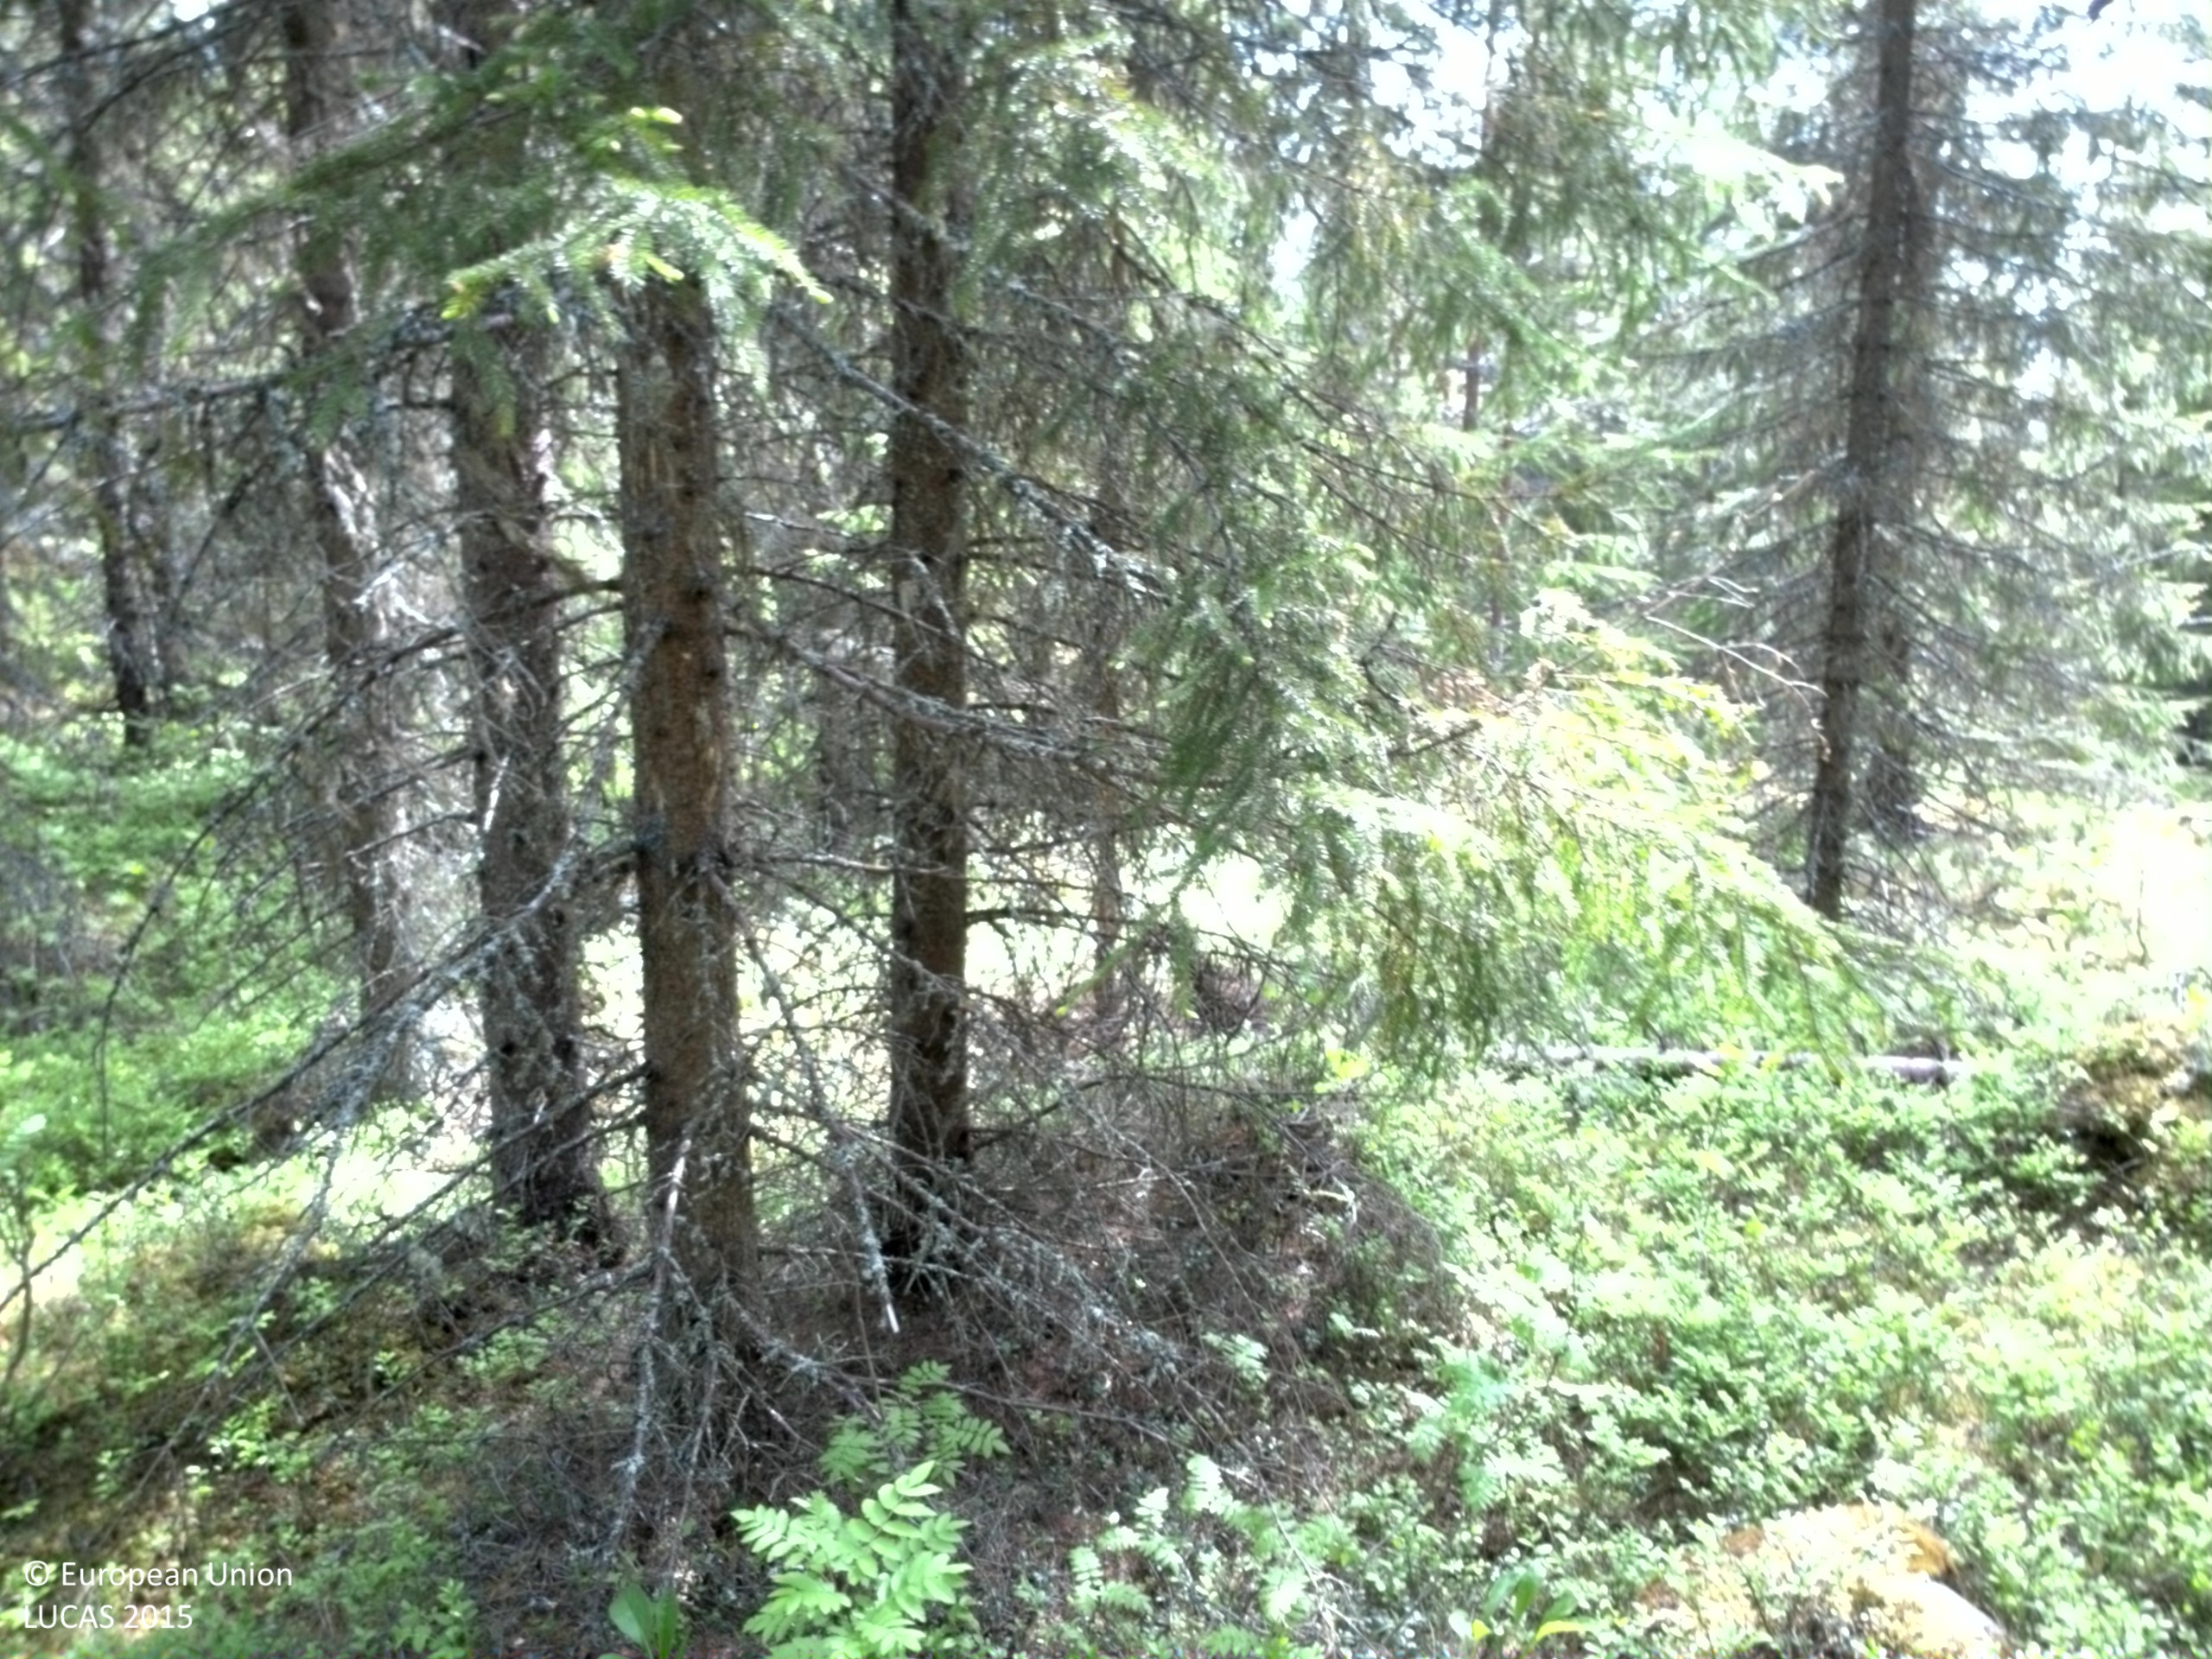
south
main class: Woodland
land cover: Spruce dominated mixed woodland
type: boreal forest
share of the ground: 50 - 75 %
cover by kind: coniferous forest trees 45 %, shrubs 40 %, broadleaved forest trees 15 %
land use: Forestry
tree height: > 5 m
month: June
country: SE
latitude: 63.2402
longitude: 17.8795
